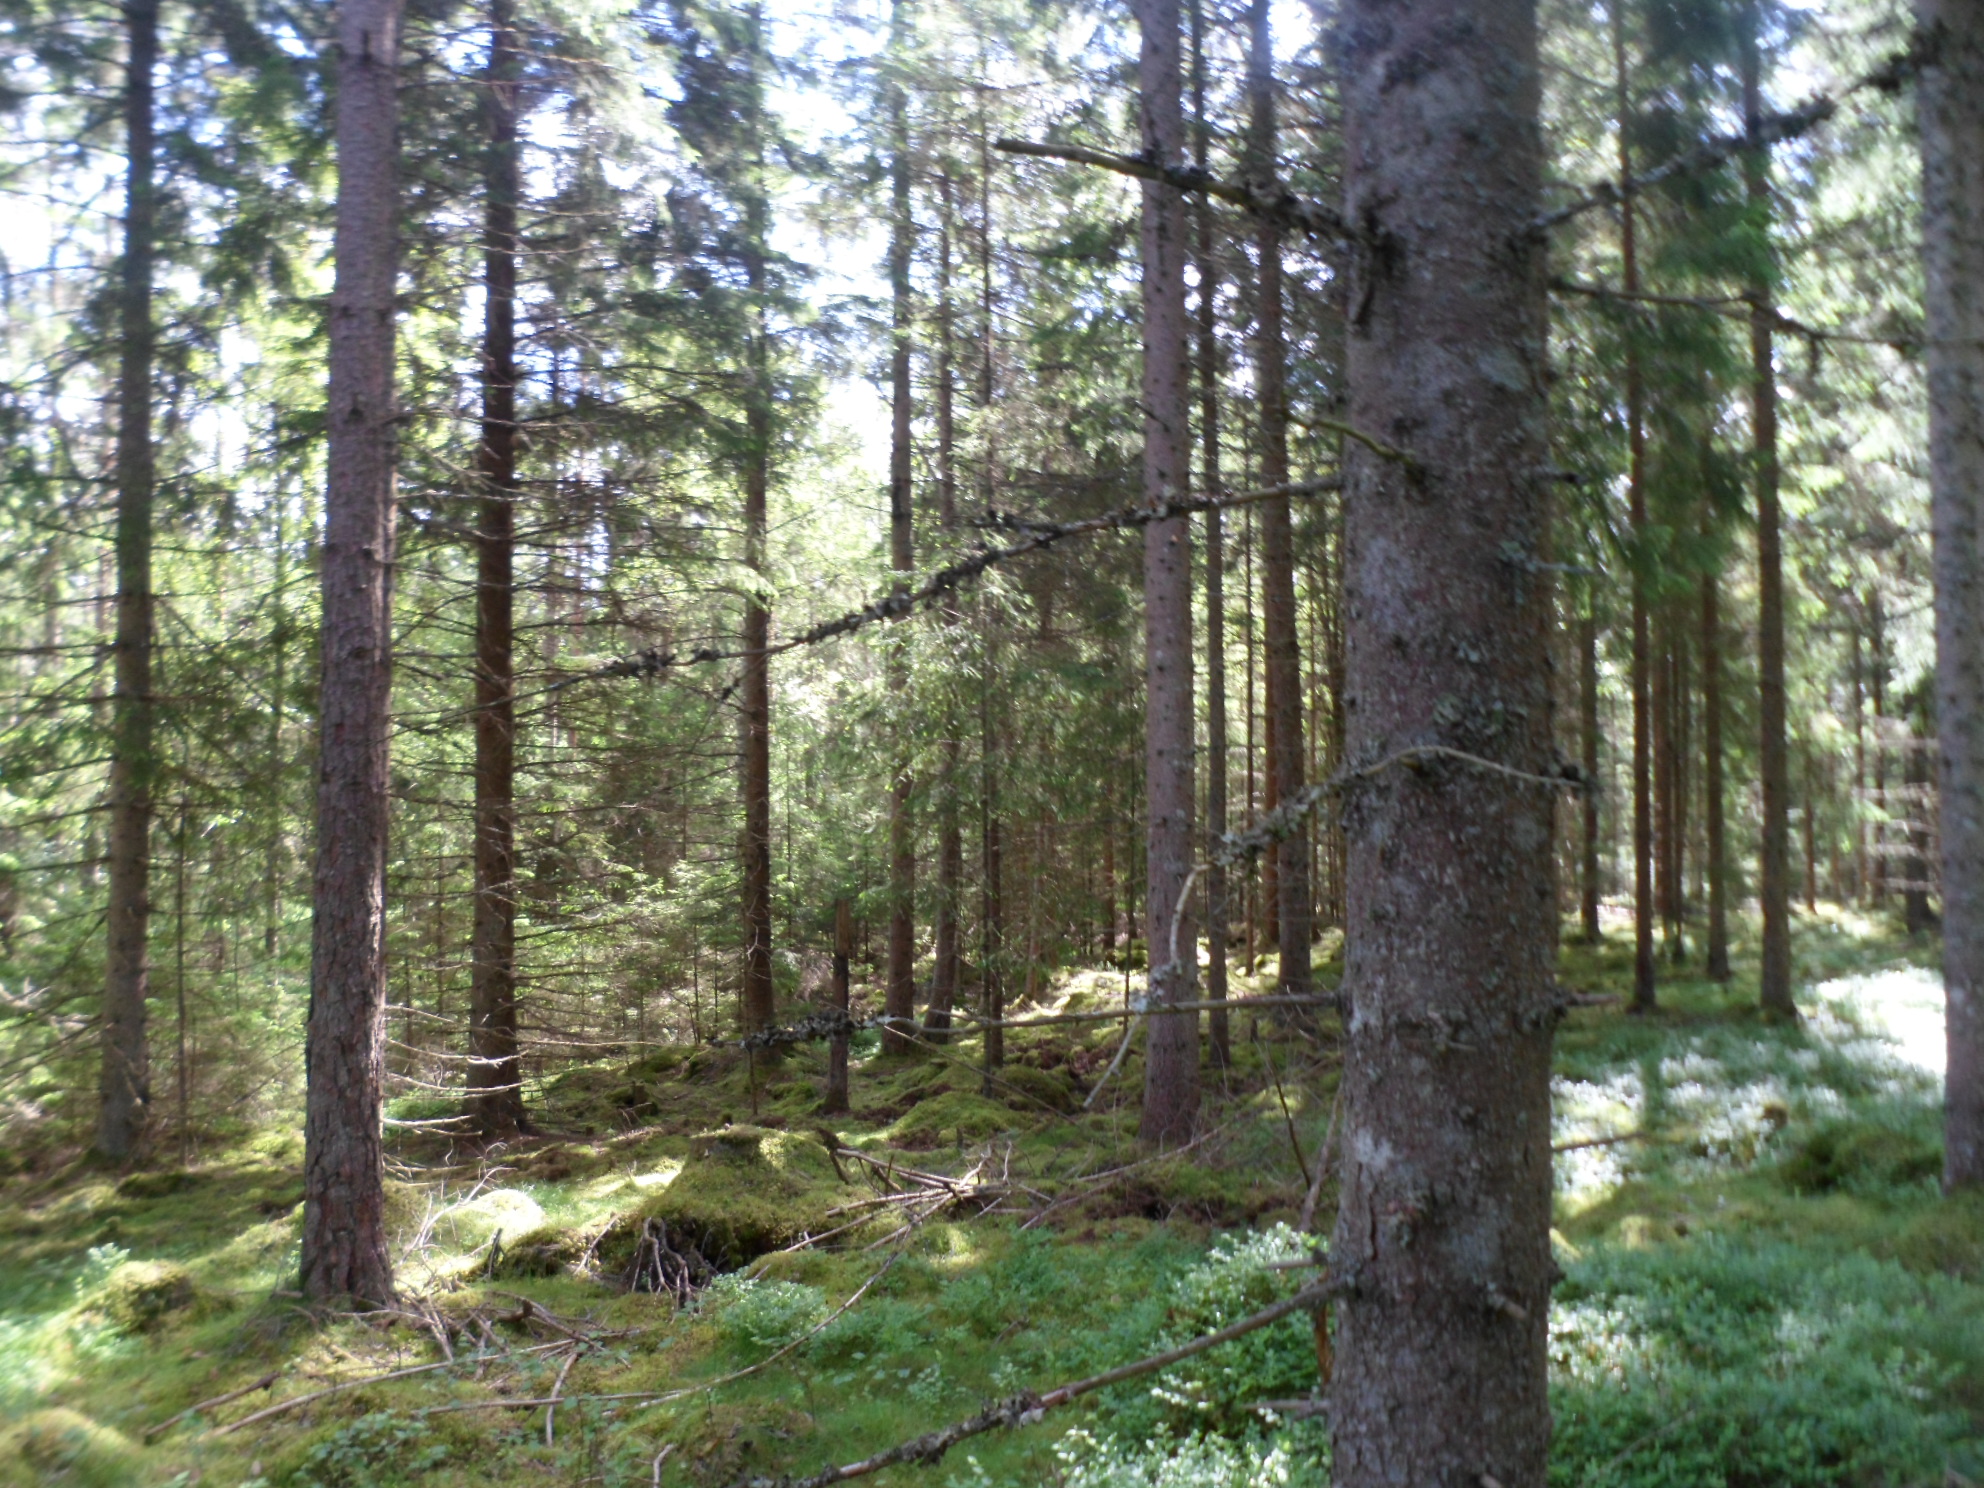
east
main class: Woodland
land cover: Spruce dominated coniferous woodland
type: boreal forest
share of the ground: 50 - 75 %
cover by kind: coniferous forest trees 60 %, lichens and mosses 20 %, shrubs 15 %, herbaceous plants 5 %
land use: Forestry
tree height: > 5 m
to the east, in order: Spruce dominated coniferous woodland; Rivers and streams; Spruce dominated coniferous woodland; Pine dominated coniferous woodland; Ditches and canals; Spruce dominated coniferous woodland; Tracks; Spruce dominated coniferous woodland; Broadleaved woodland
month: June
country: SE
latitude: 57.1414
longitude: 14.8386
